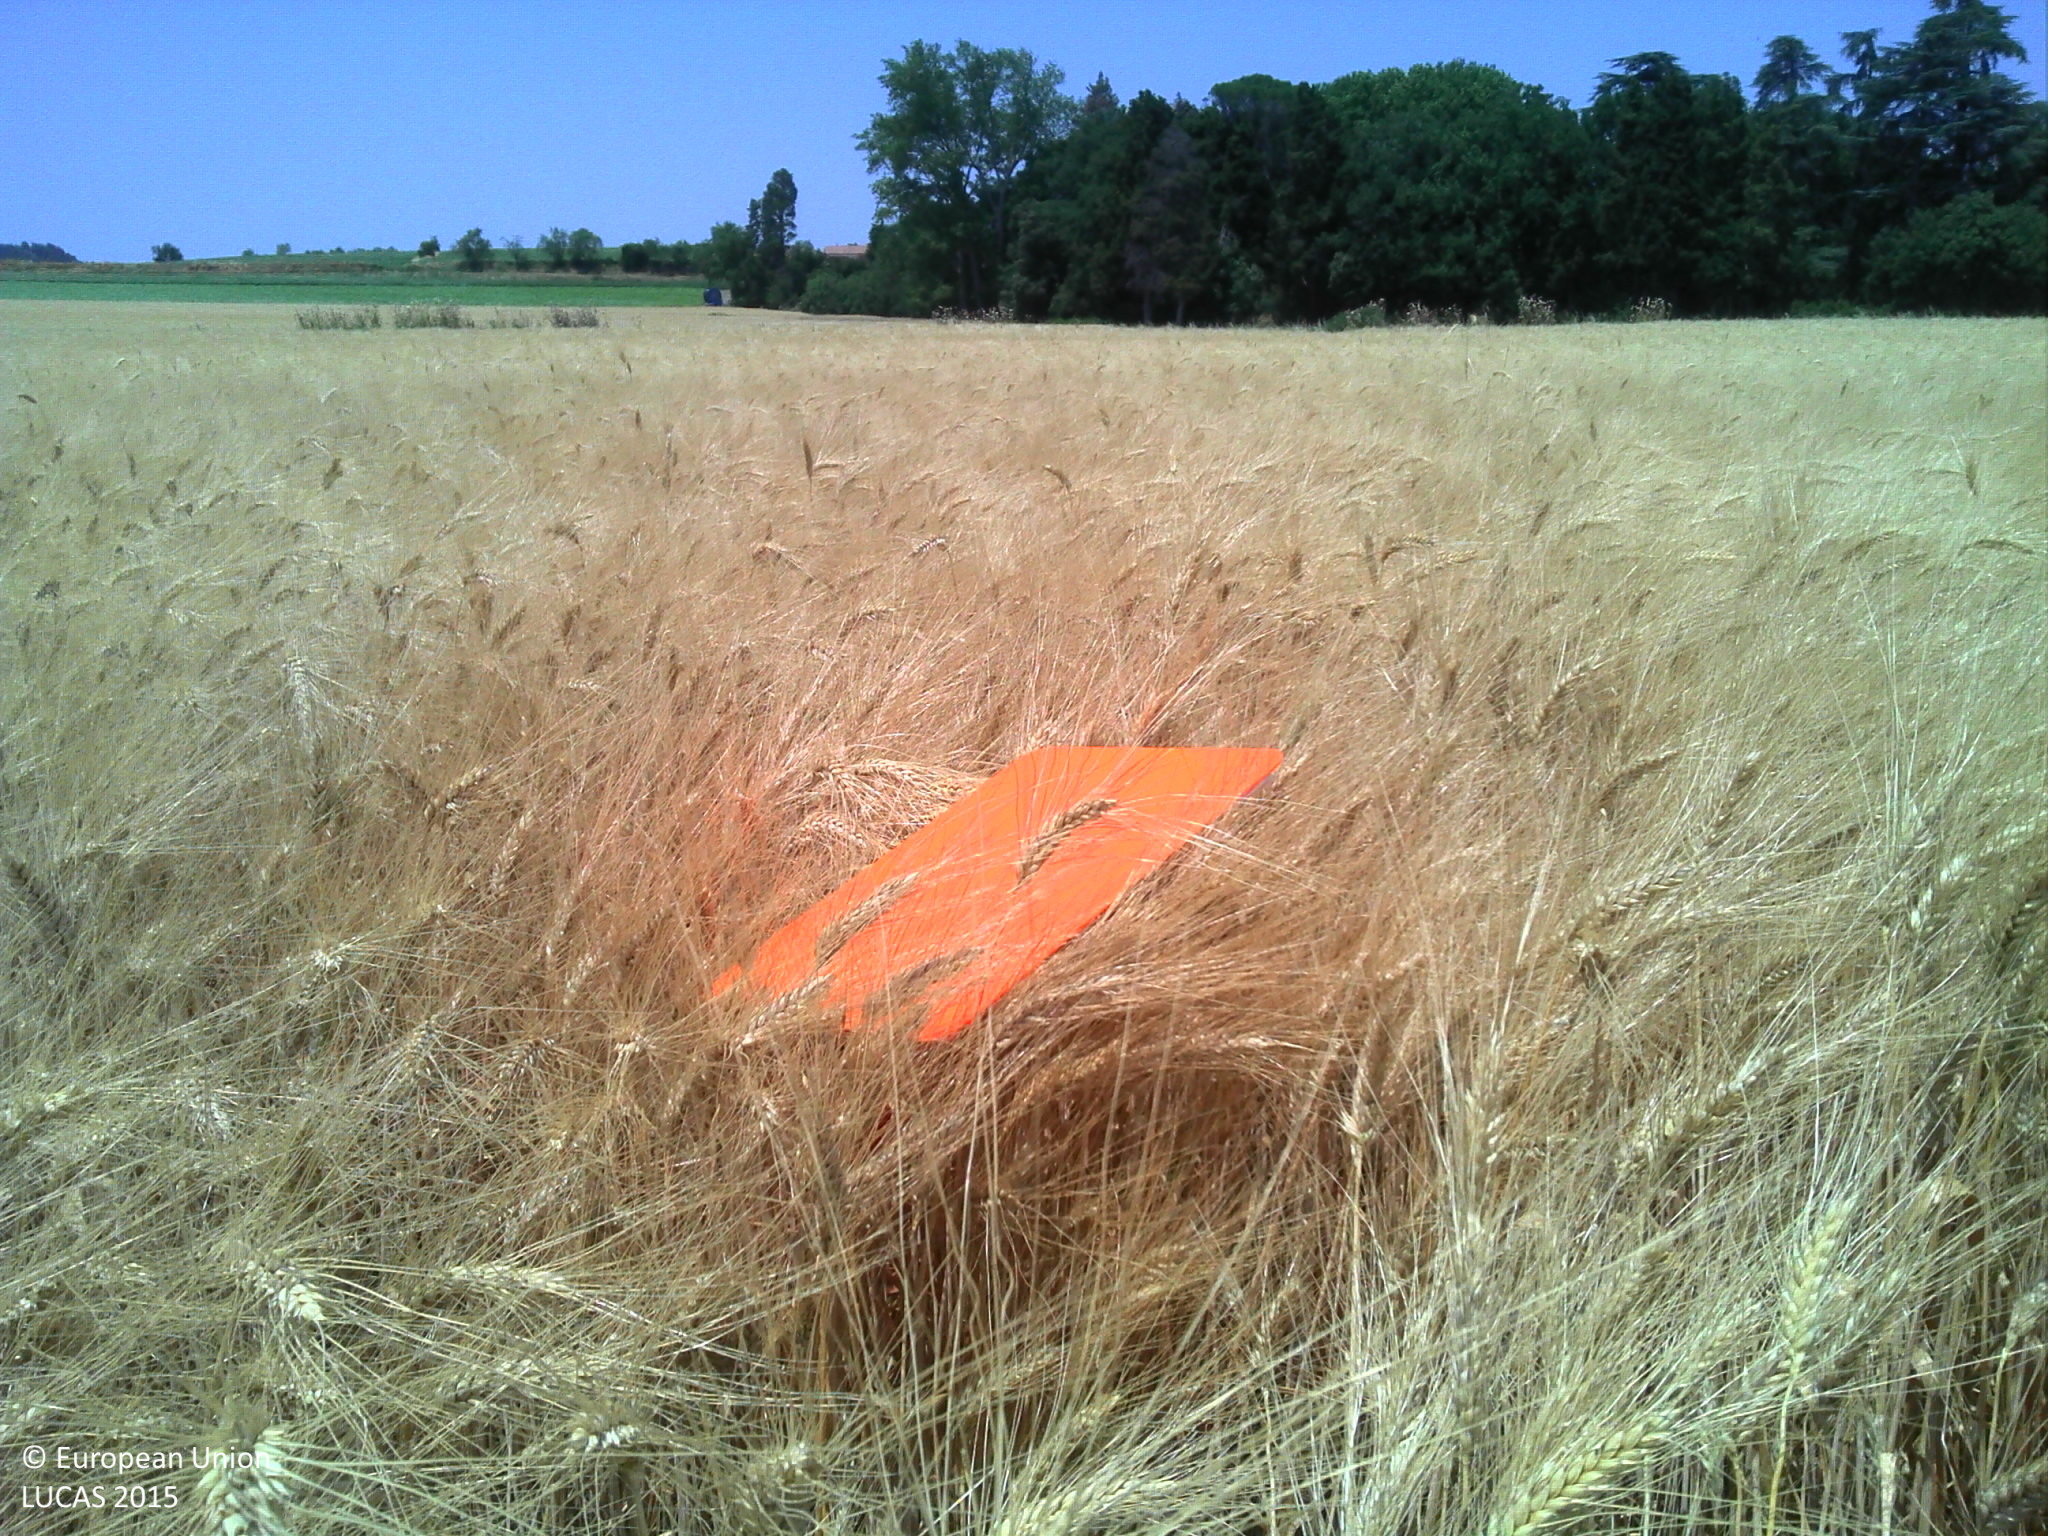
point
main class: Cropland
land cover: Durum wheat
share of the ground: > 75 %
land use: Agriculture (excluding fallow land and kitchen gardens)
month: June
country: FR
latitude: 43.2111
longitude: 2.0432
